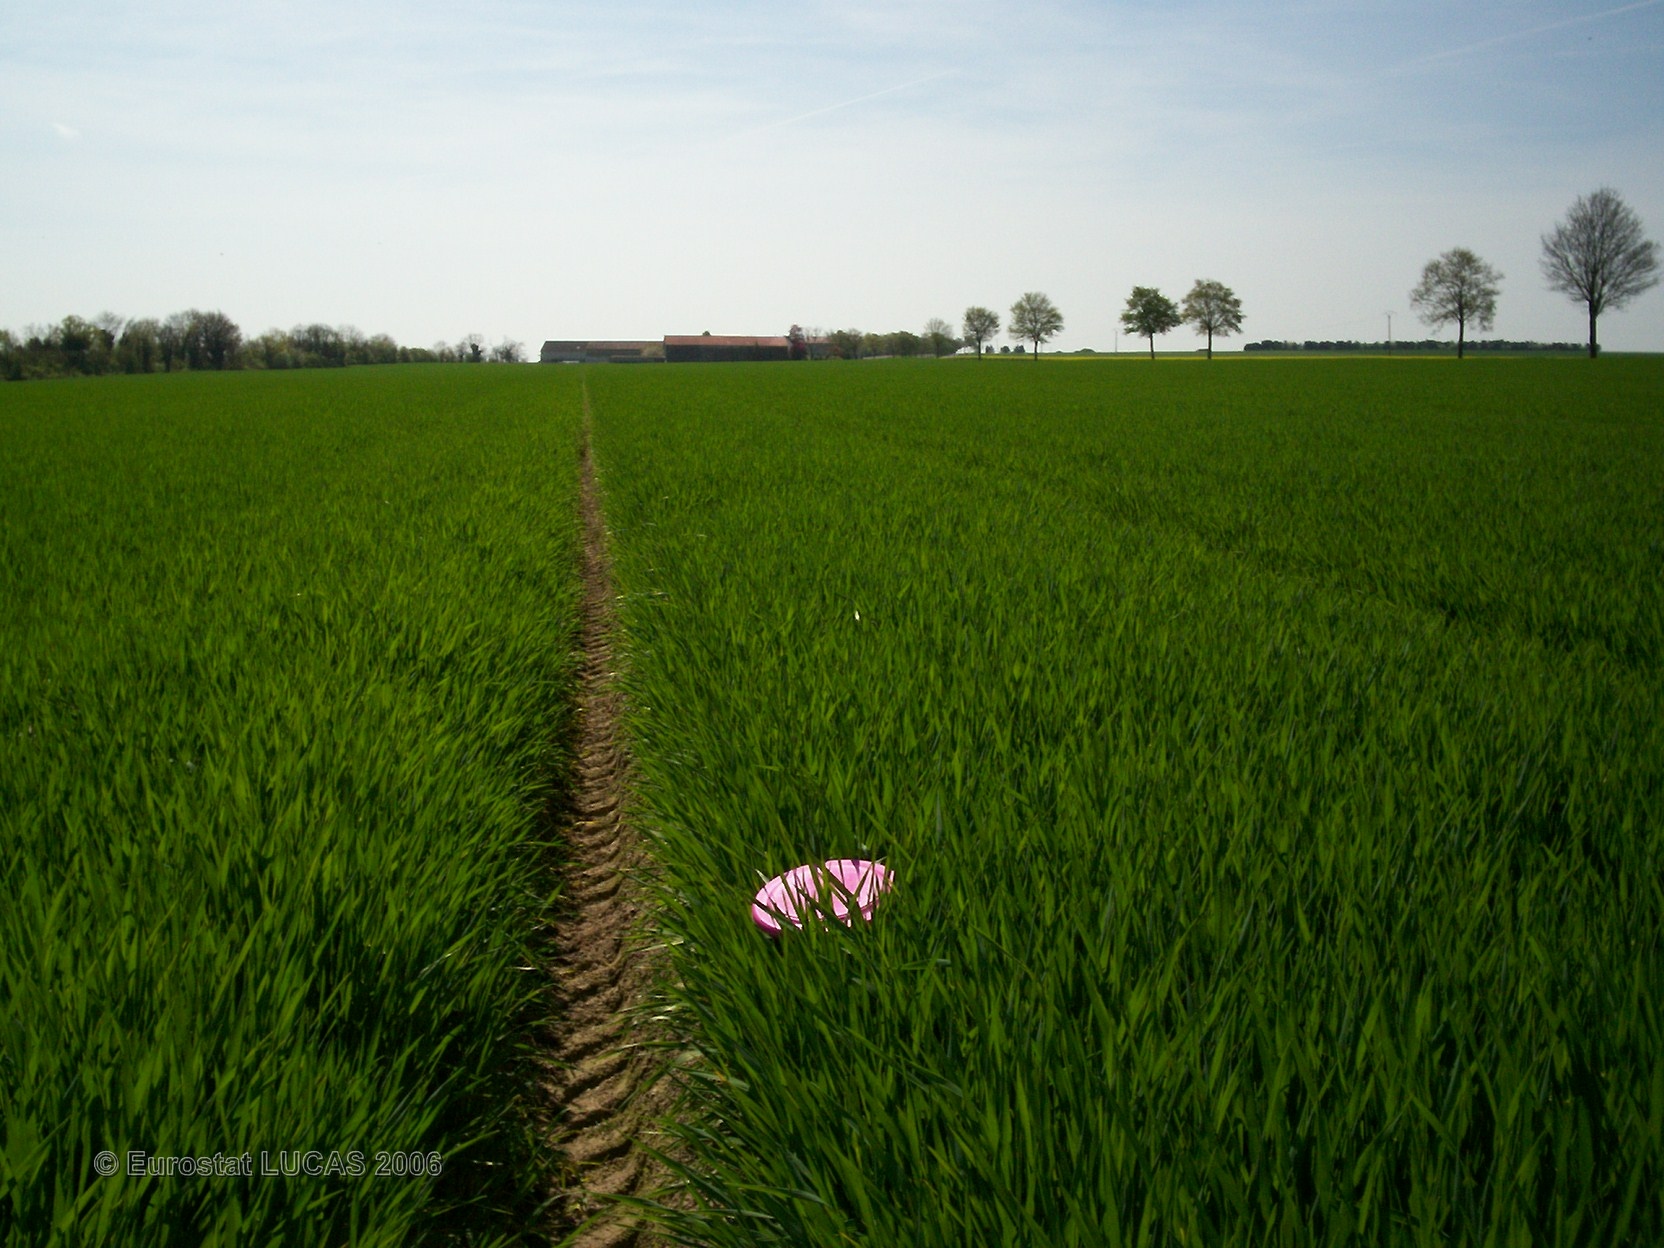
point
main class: Cropland
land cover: Barley
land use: Agriculture (excluding fallow land and kitchen gardens)
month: May
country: FR
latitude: 48.8758
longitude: 4.4199
